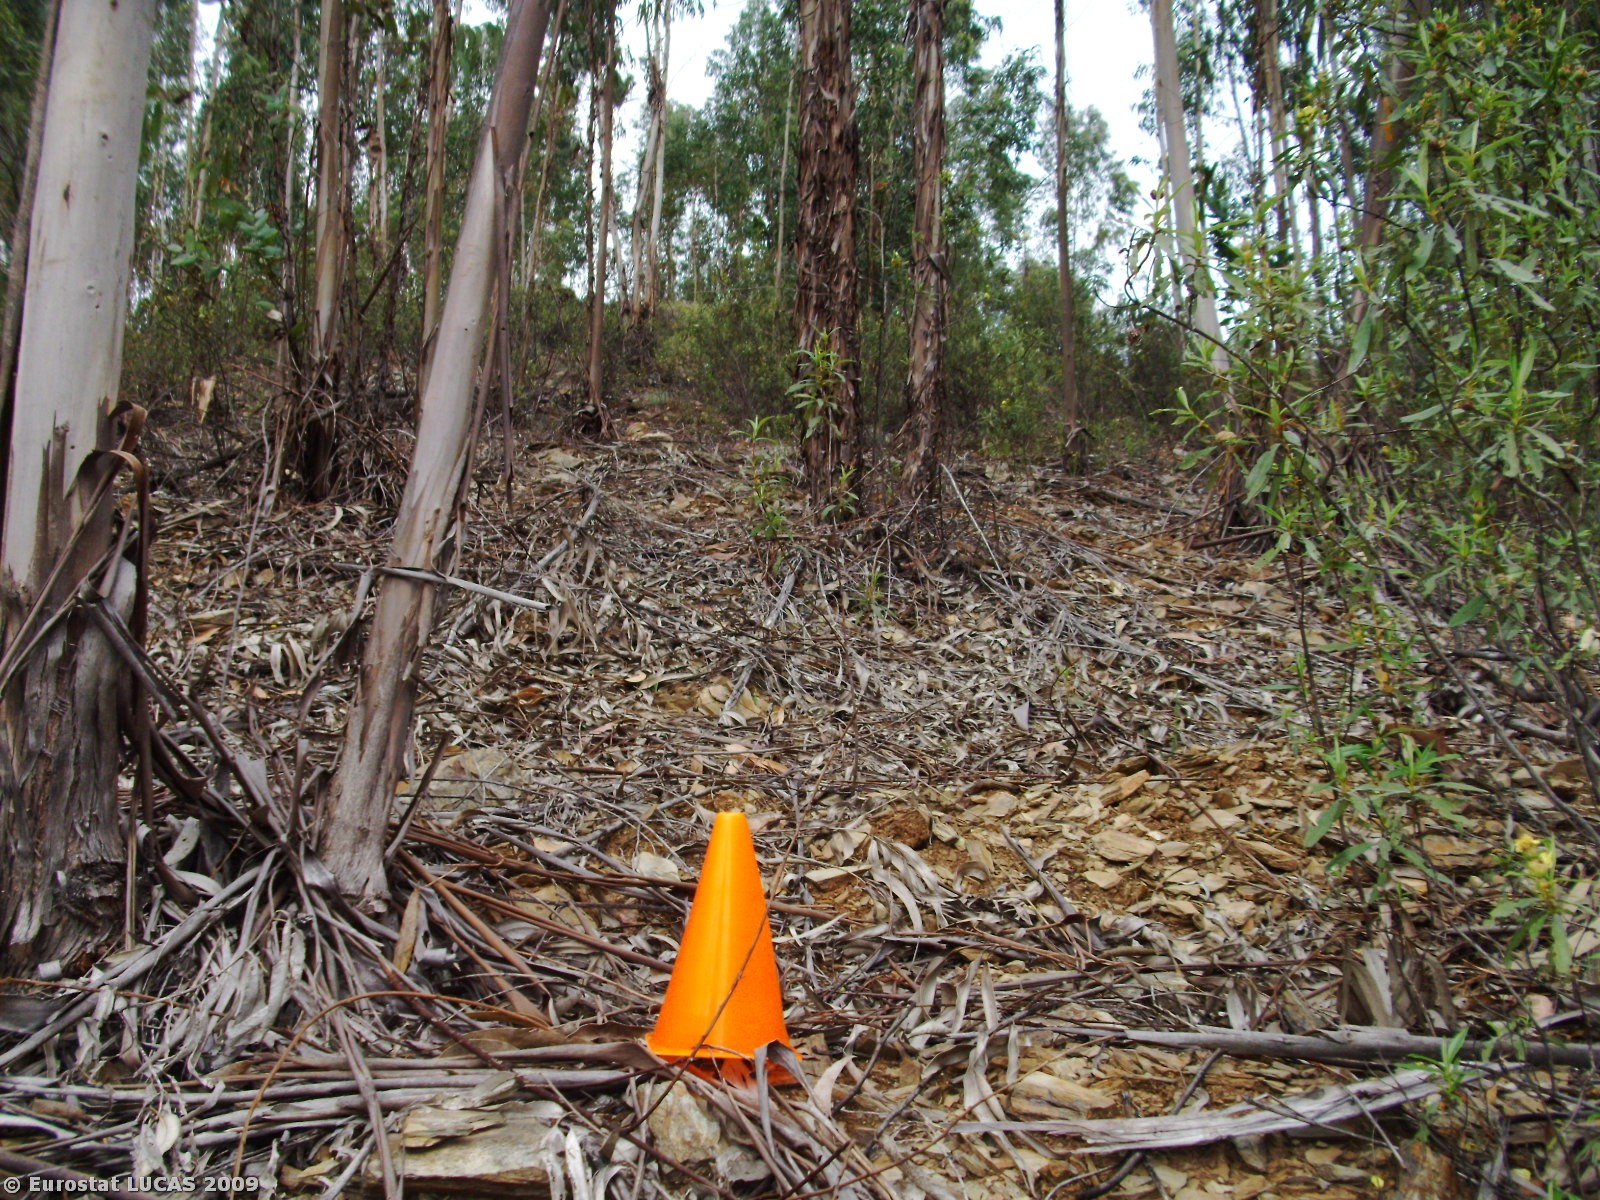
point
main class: Woodland
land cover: Broadleaved woodland
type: plantations and self-sown exotic forest
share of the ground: > 75 %
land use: Forestry
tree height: > 5 m
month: April
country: PT
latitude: 39.7648
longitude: -7.5271
